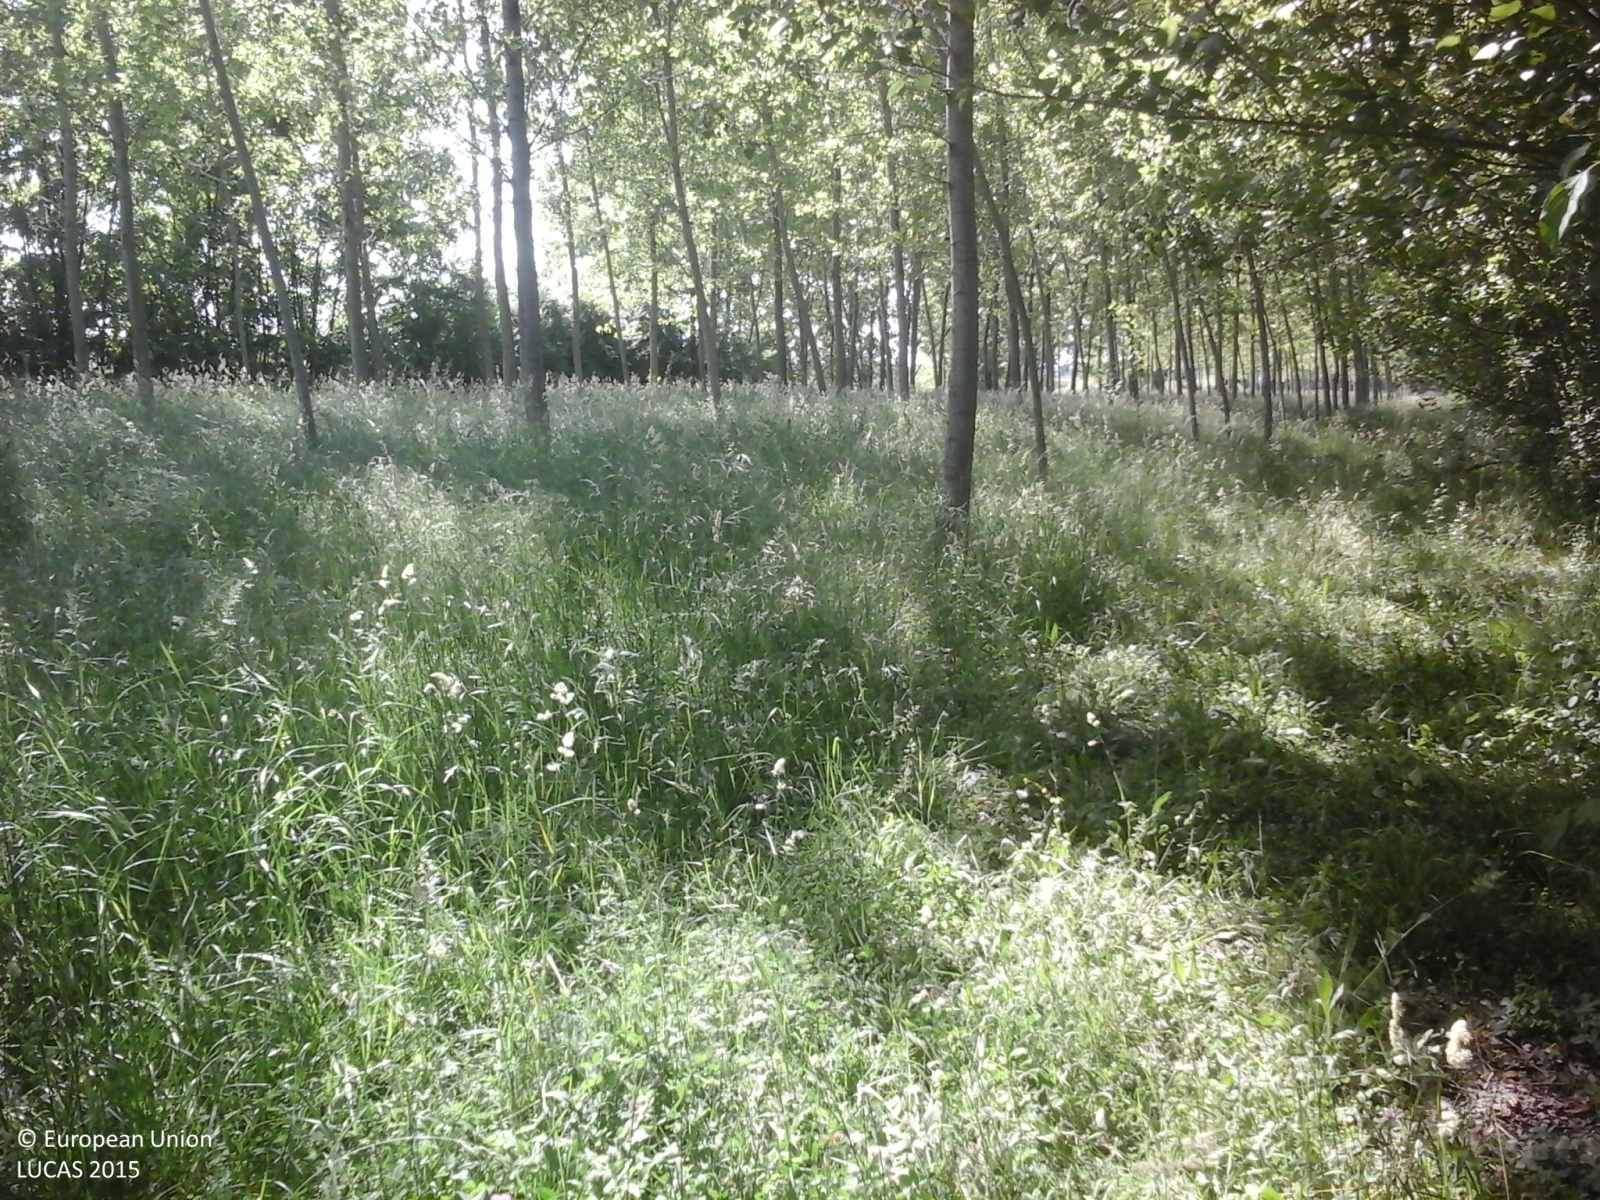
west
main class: Woodland
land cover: Broadleaved woodland
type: non-riverine alder, birch or aspen forest
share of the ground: > 75 %
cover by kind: broadleaved forest trees 100 %
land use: Forestry
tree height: > 5 m
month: May
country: IT
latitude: 45.0307
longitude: 11.0261
